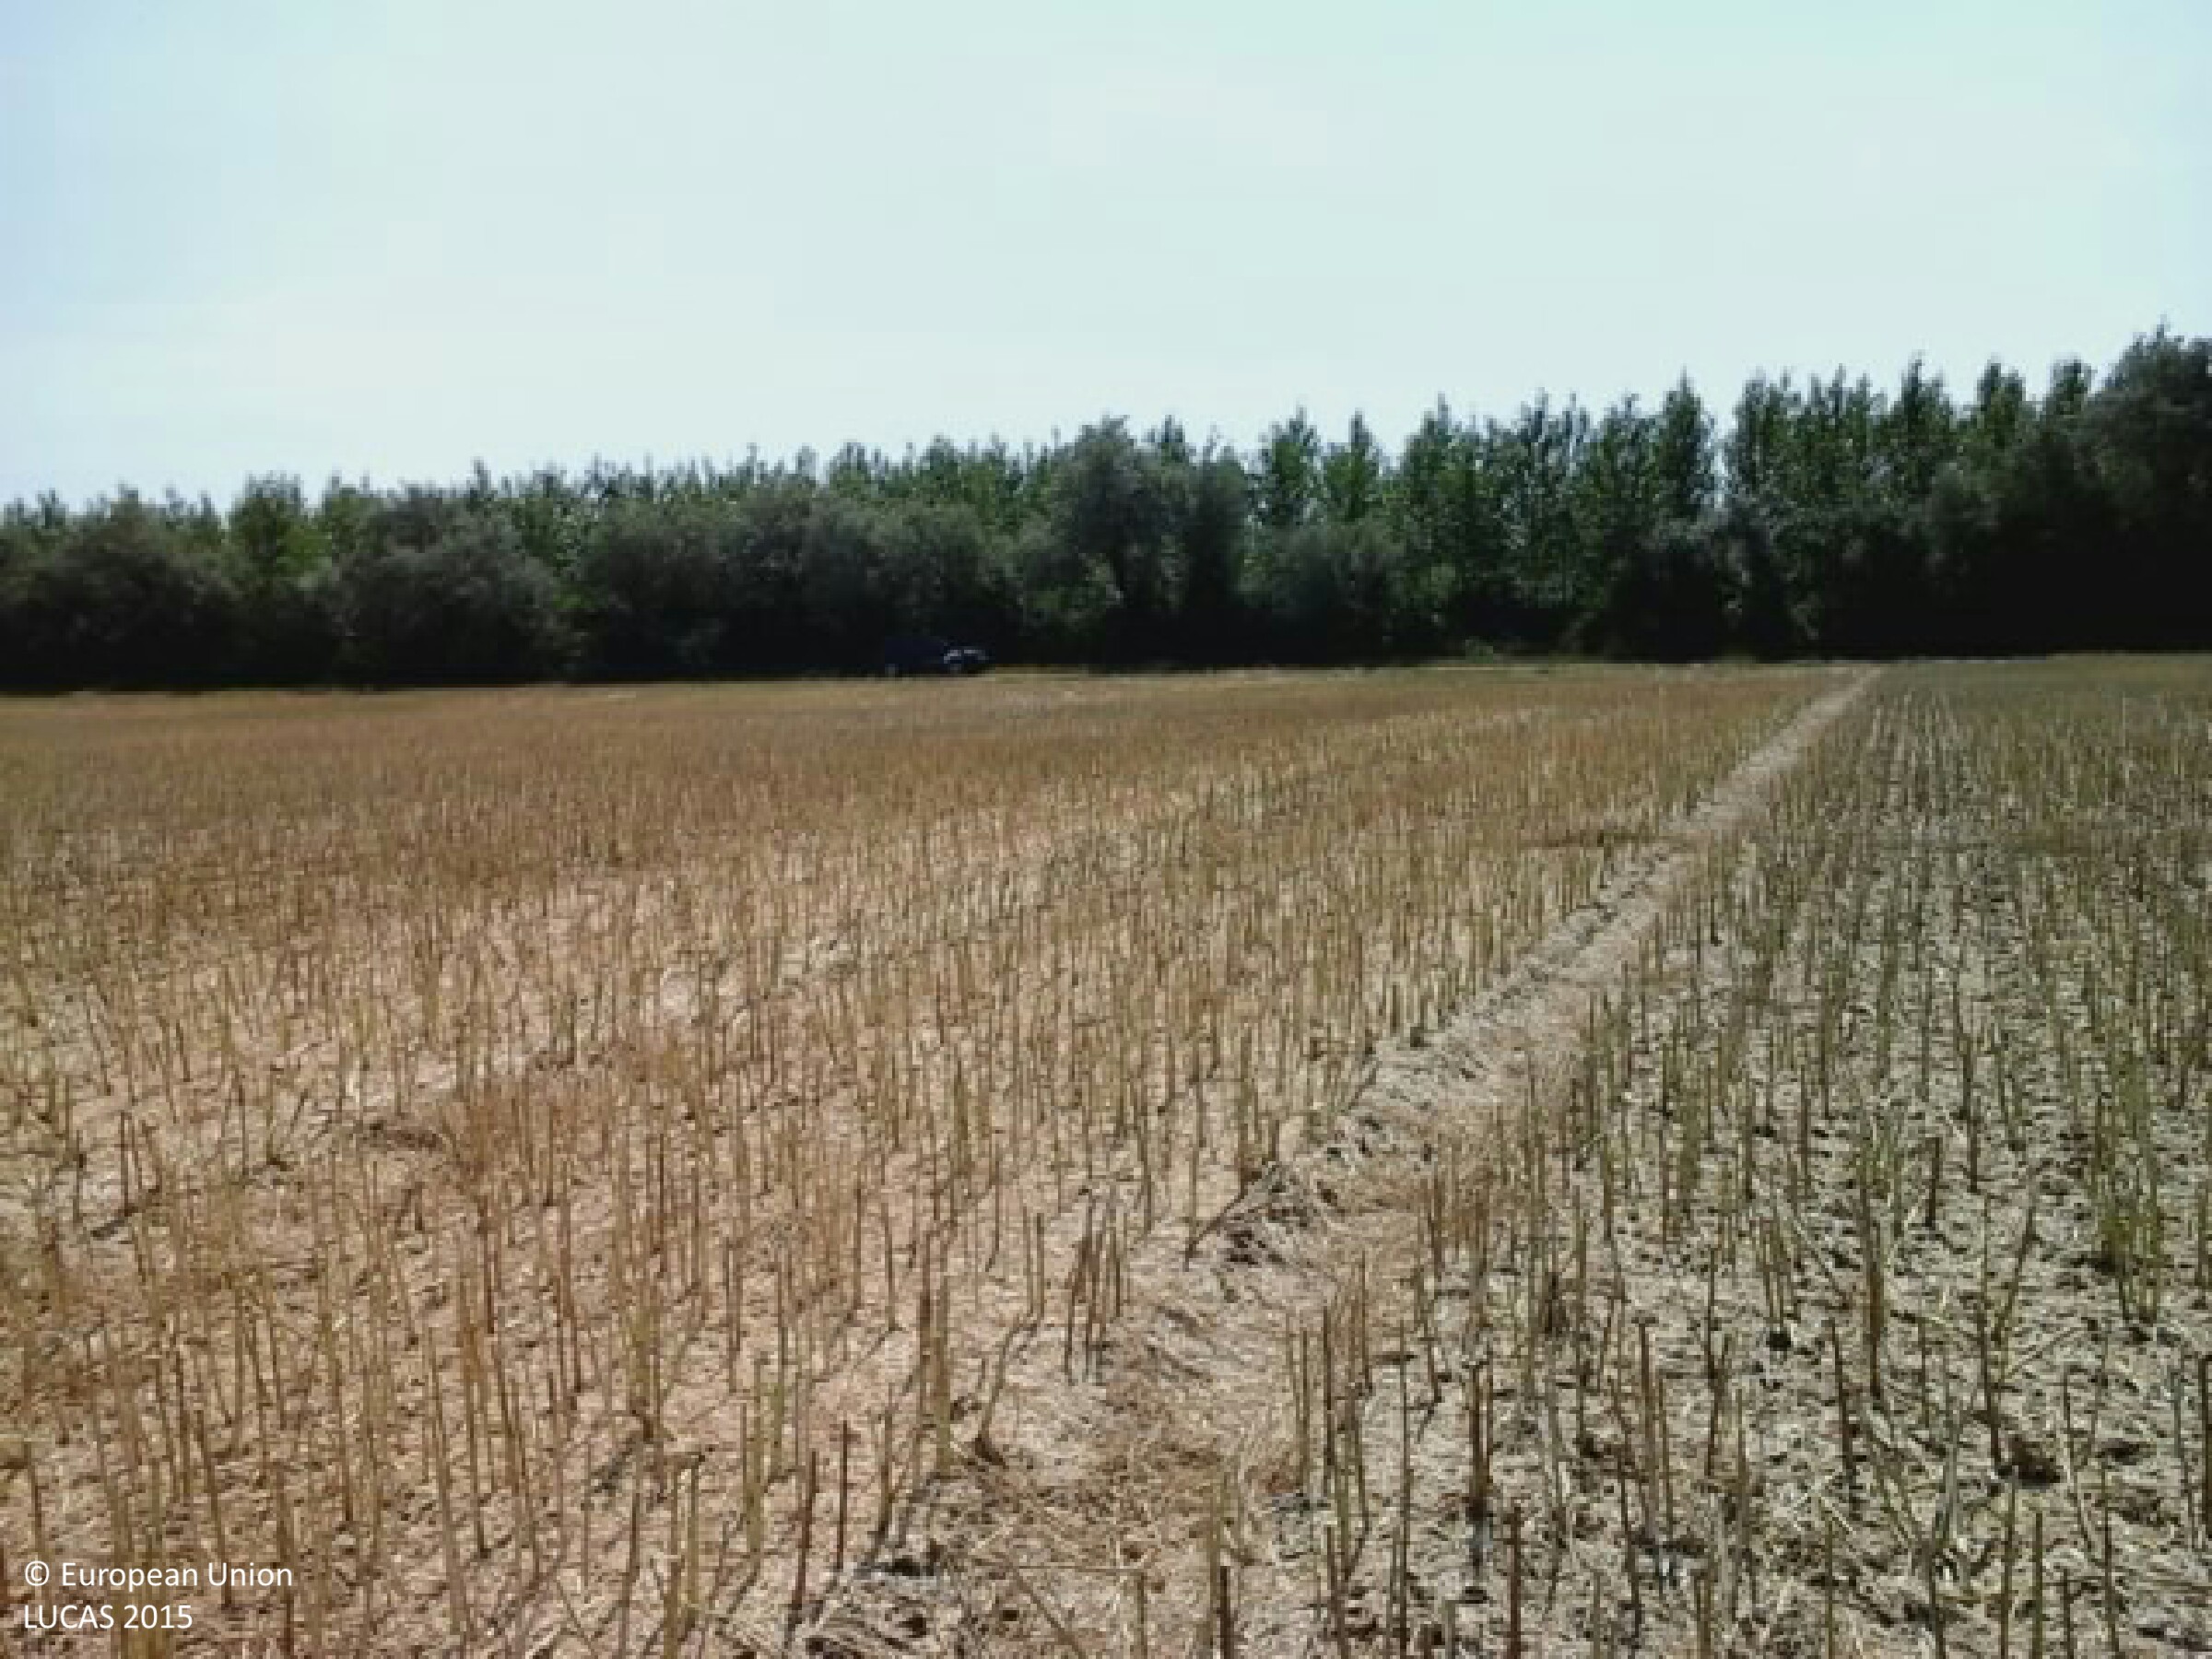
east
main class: Cropland
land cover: Rape and turnip rape
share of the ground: > 75 %
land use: Agriculture (excluding fallow land and kitchen gardens)
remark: Harvested field
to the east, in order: Rape and turnip rape; Grass margins; Tracks; Grass margins; Broadleaved woodland; Grassland without tree/shrub cover; Fences; Grassland with sparse tree/shrub cover
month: June
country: HU
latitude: 47.4501
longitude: 19.2901
